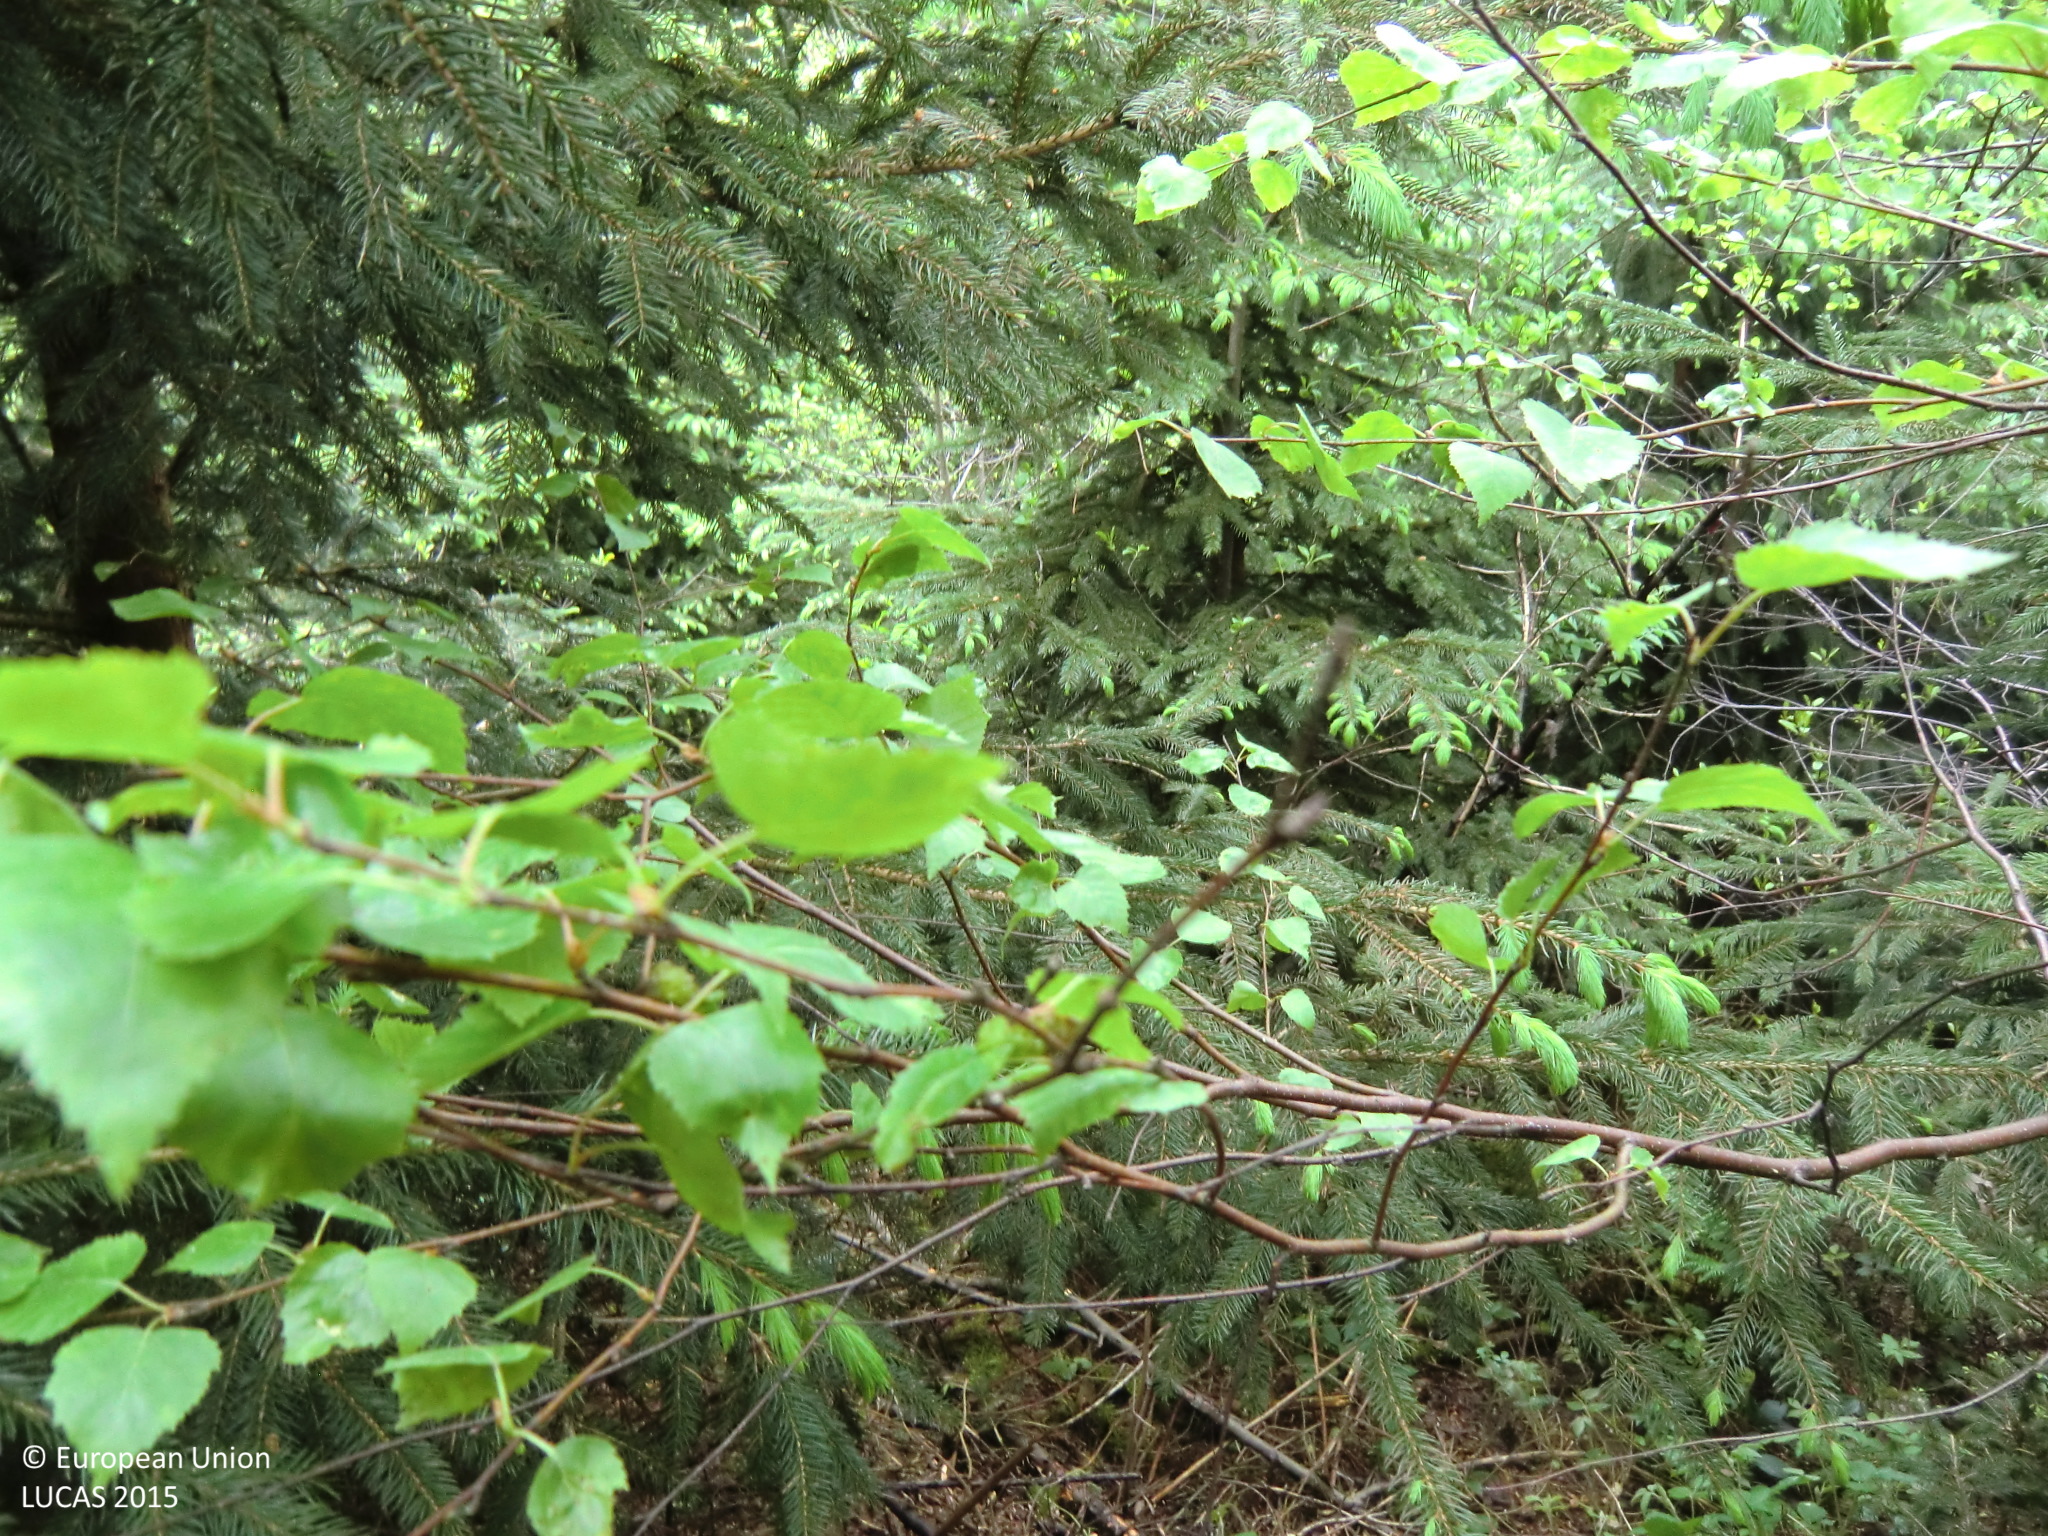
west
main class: Woodland
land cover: Spruce dominated mixed woodland
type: hemiboreal forest and nemoral coniferous forest and mixed broadleaved-coniferous forest
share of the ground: > 75 %
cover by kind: coniferous forest trees 40 %, broadleaved forest trees 40 %, shrubs 10 %, herbaceous plants 10 %
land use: Forestry
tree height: < 5 m
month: May
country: AT
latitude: 48.4793
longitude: 14.3701
